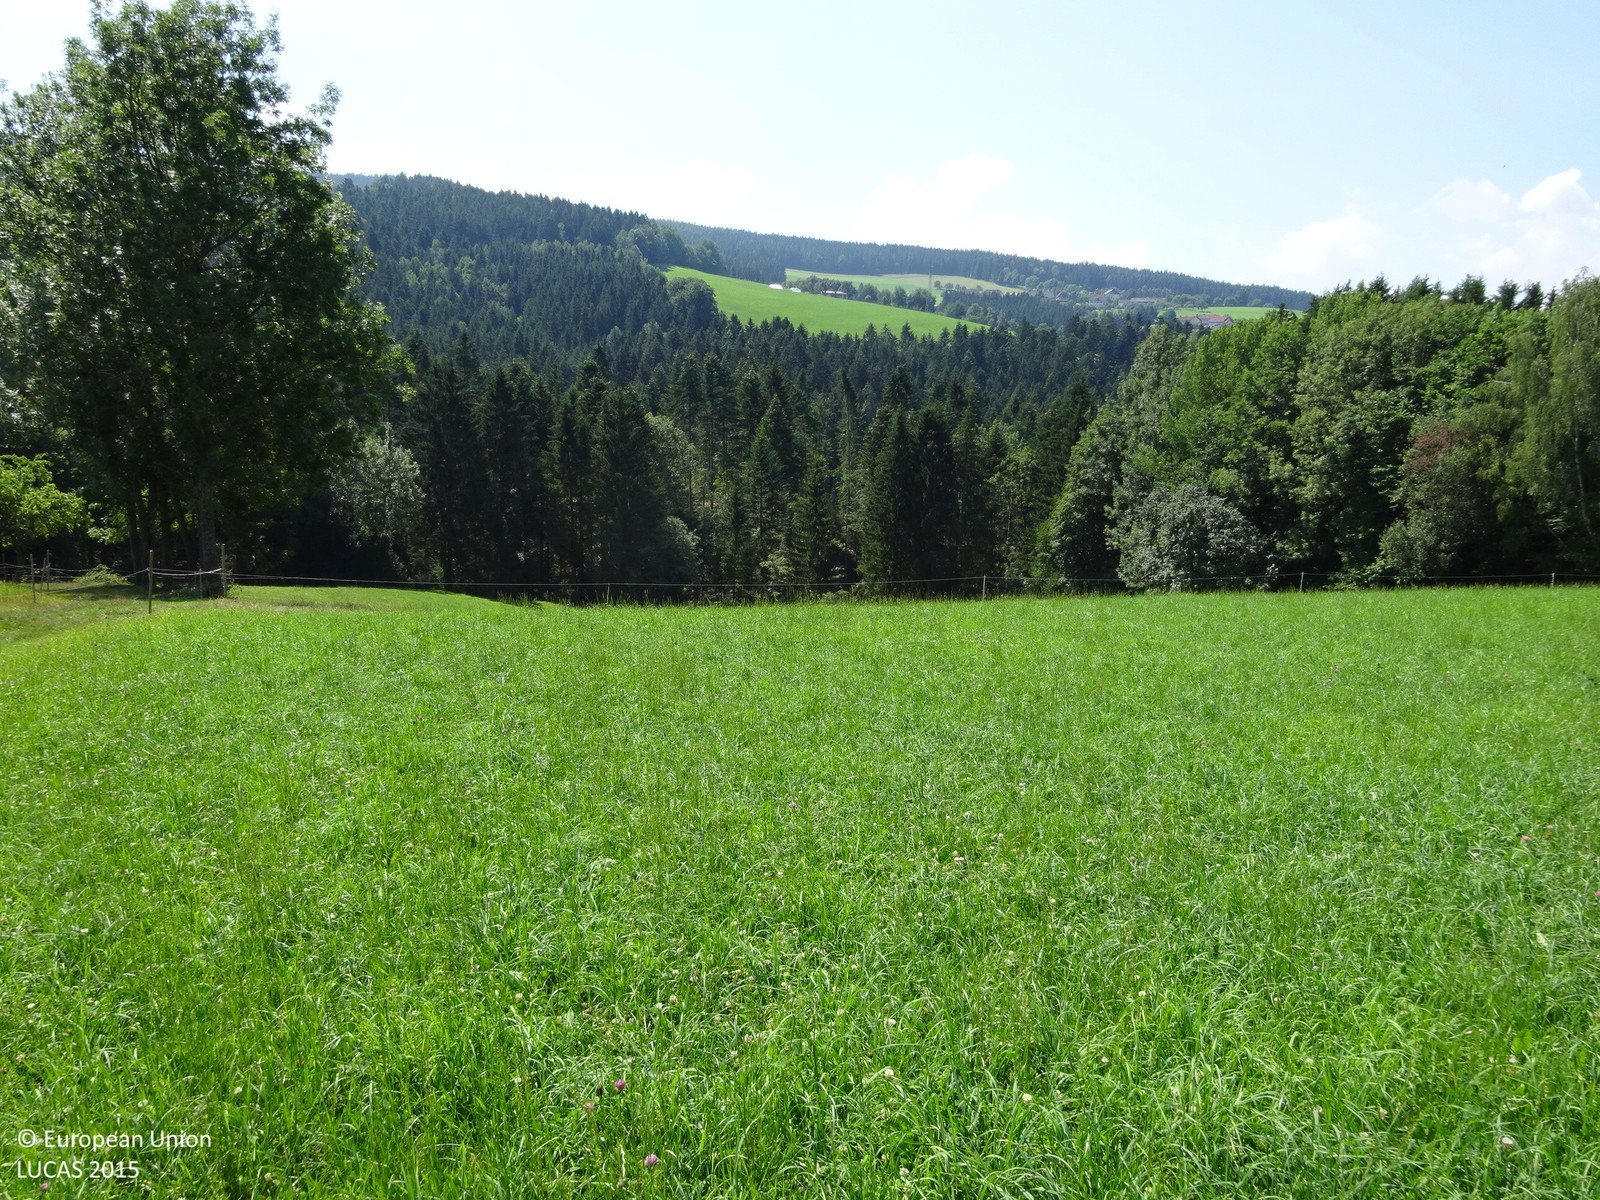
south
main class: Grassland
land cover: Grassland without tree/shrub cover
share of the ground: > 75 %
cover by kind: herbaceous plants 100 %
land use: Agriculture (excluding fallow land and kitchen gardens)
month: August
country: AT
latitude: 47.3706
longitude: 15.7353
